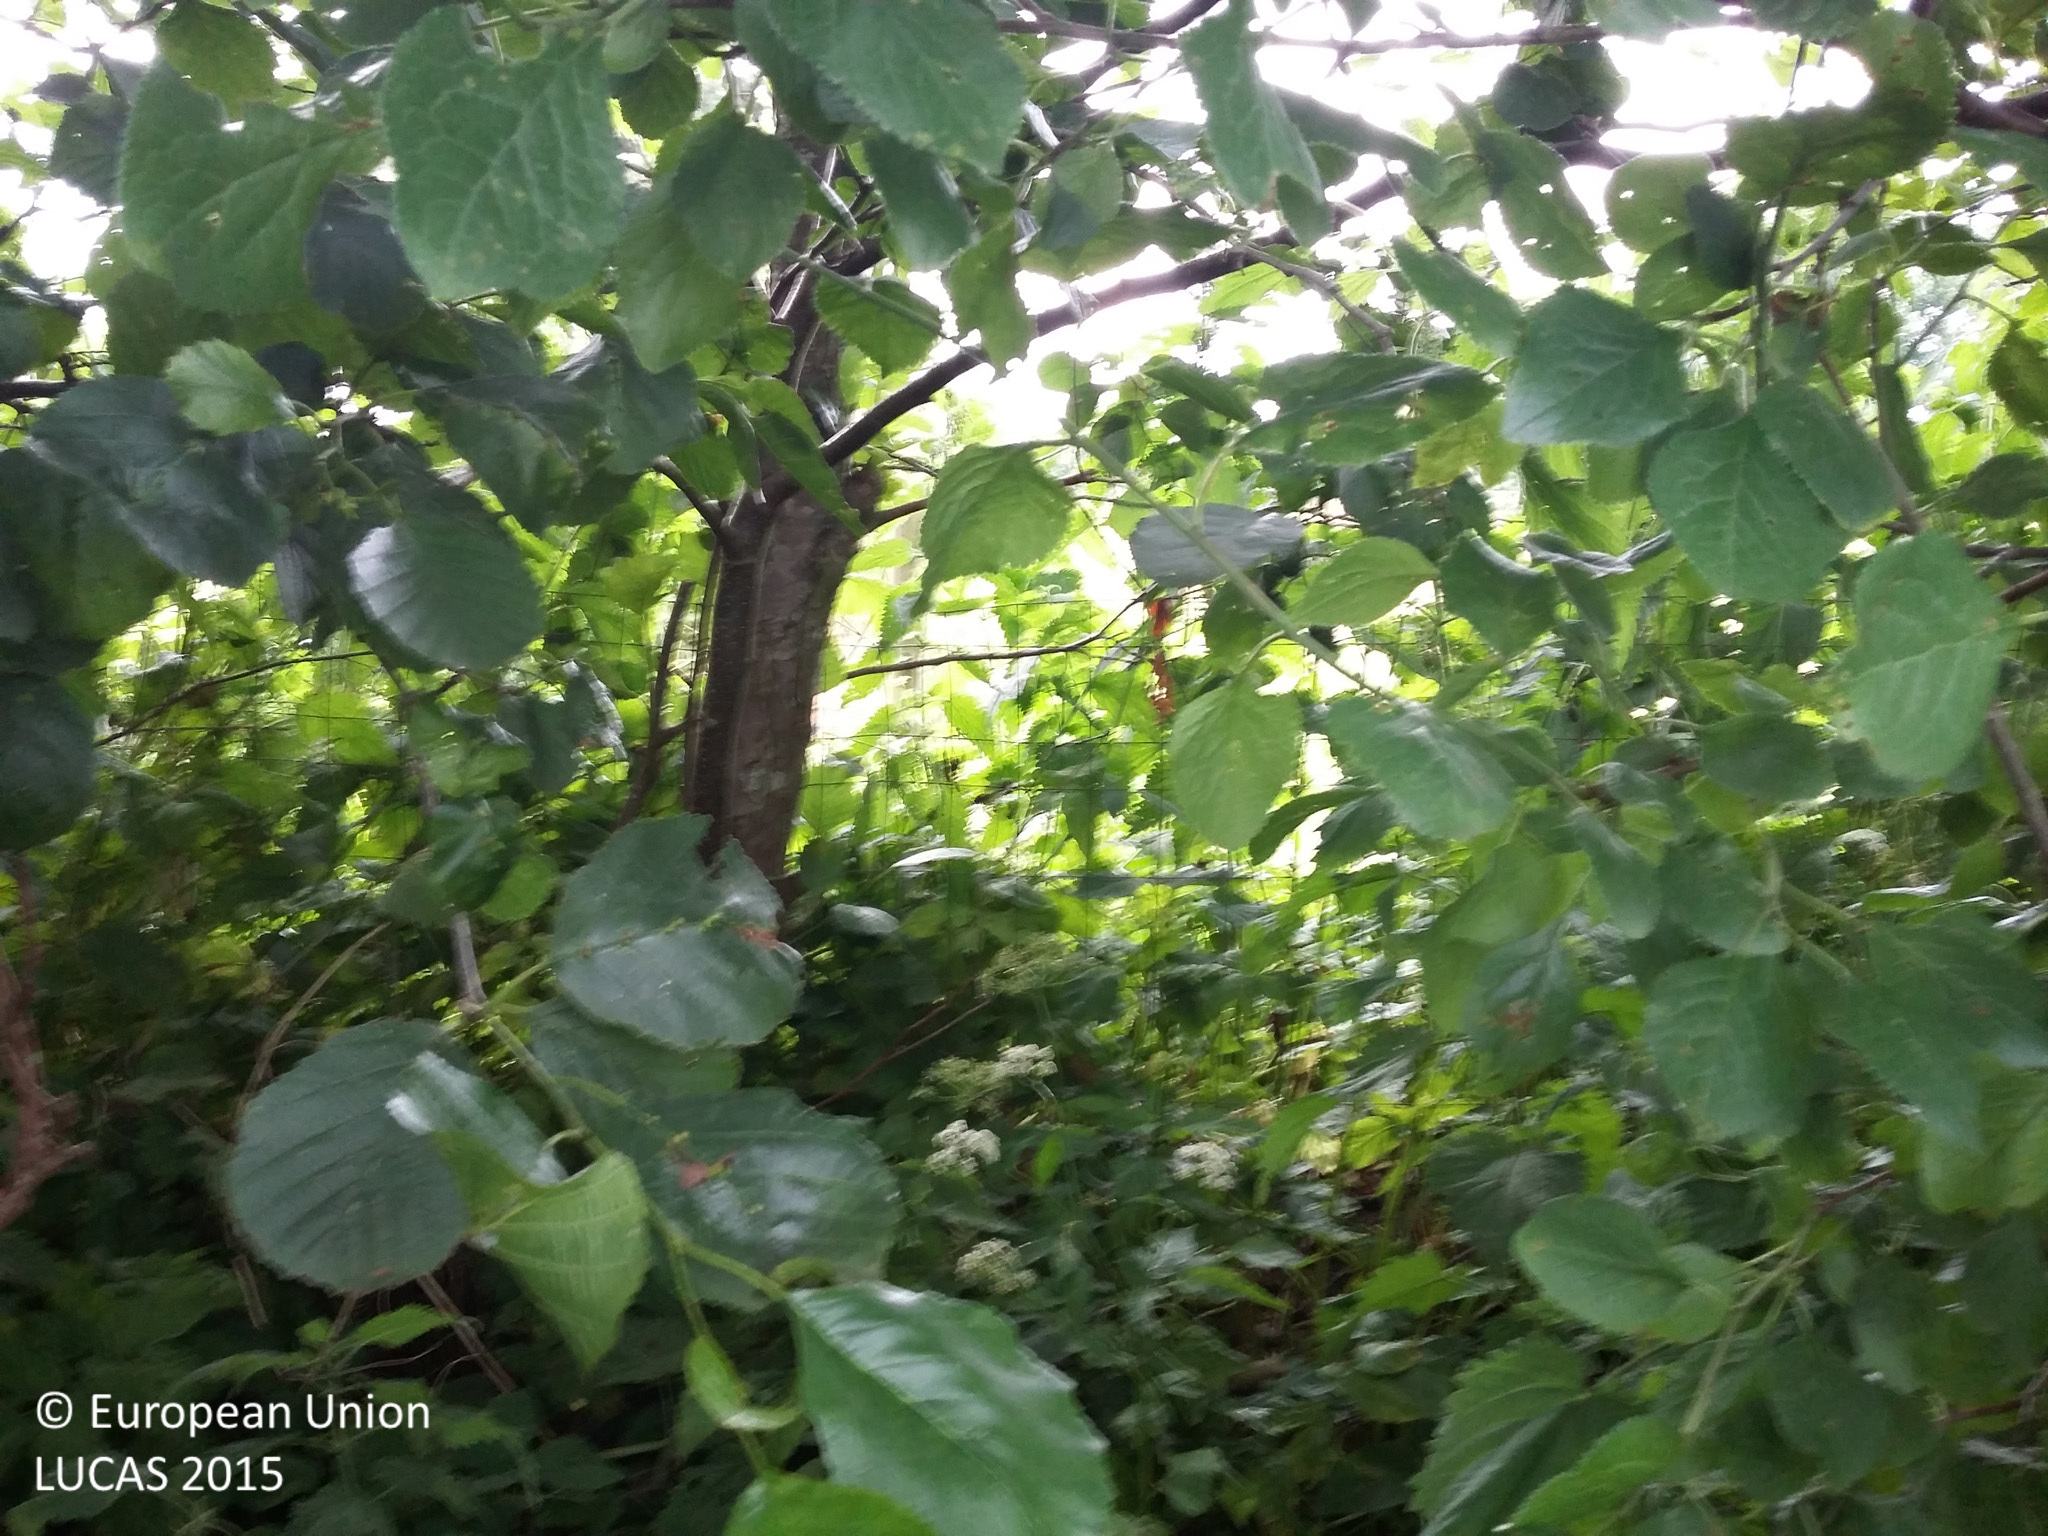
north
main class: Woodland
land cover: Broadleaved woodland
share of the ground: > 75 %
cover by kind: broadleaved forest trees 90 %, herbaceous plants 10 %
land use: Forestry
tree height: > 5 m
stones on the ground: < 10 %
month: July
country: DK
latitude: 55.5691
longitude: 11.3784
